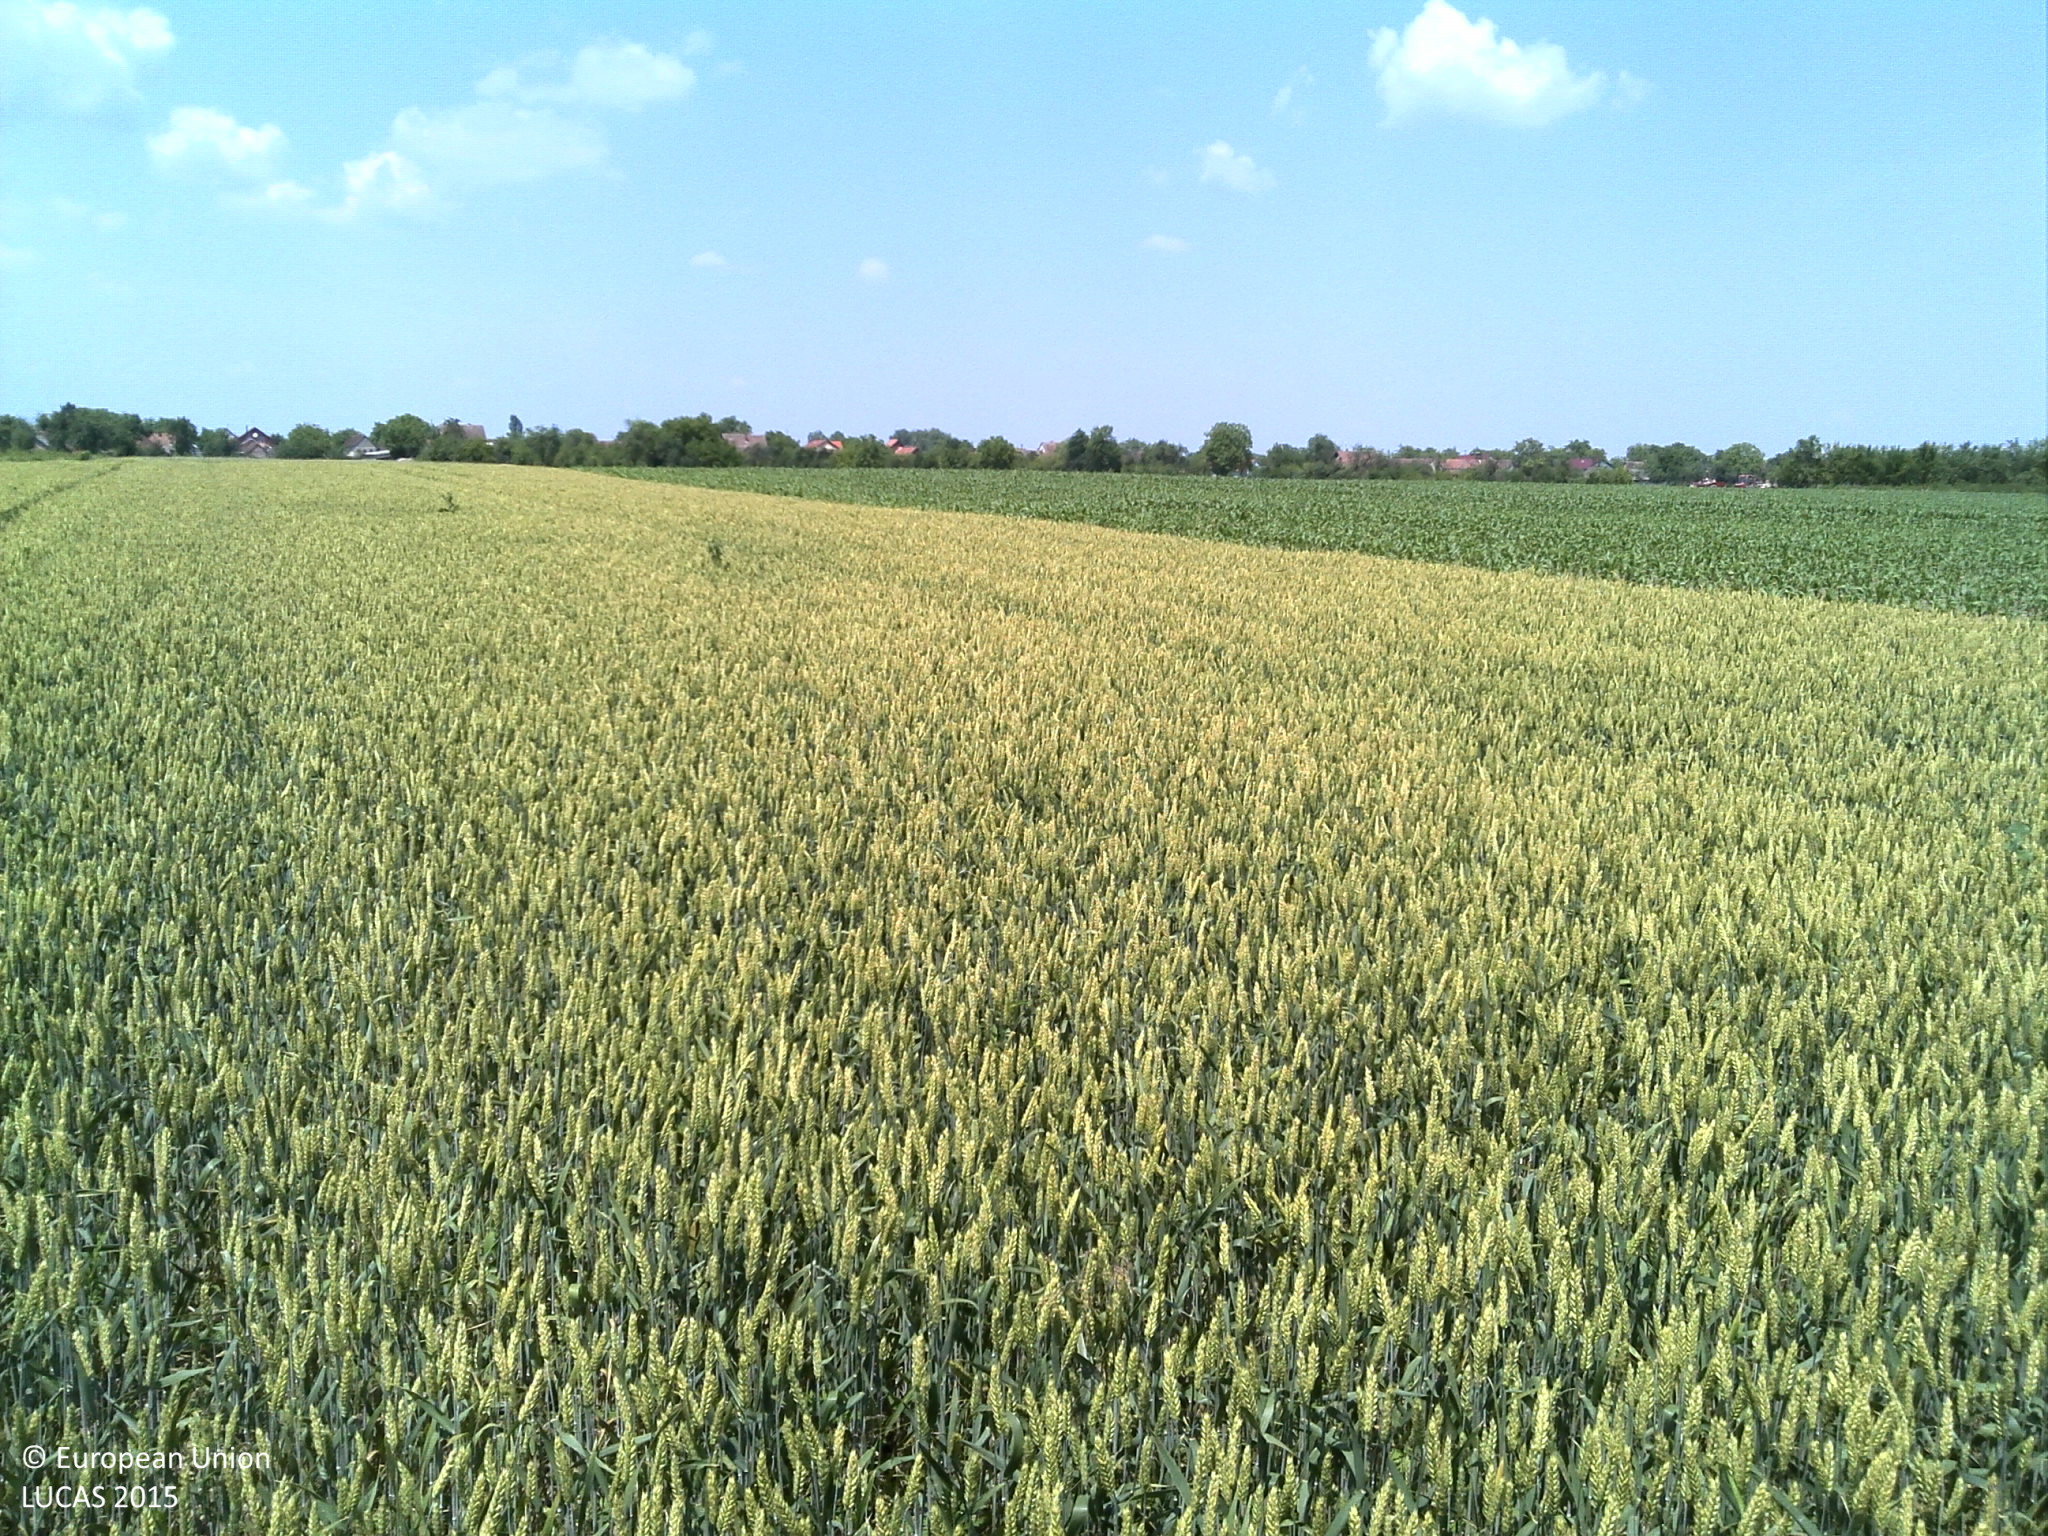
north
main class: Cropland
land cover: Common wheat
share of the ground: > 75 %
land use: Agriculture (excluding fallow land and kitchen gardens)
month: June
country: HR
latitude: 44.9410
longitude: 18.9663
